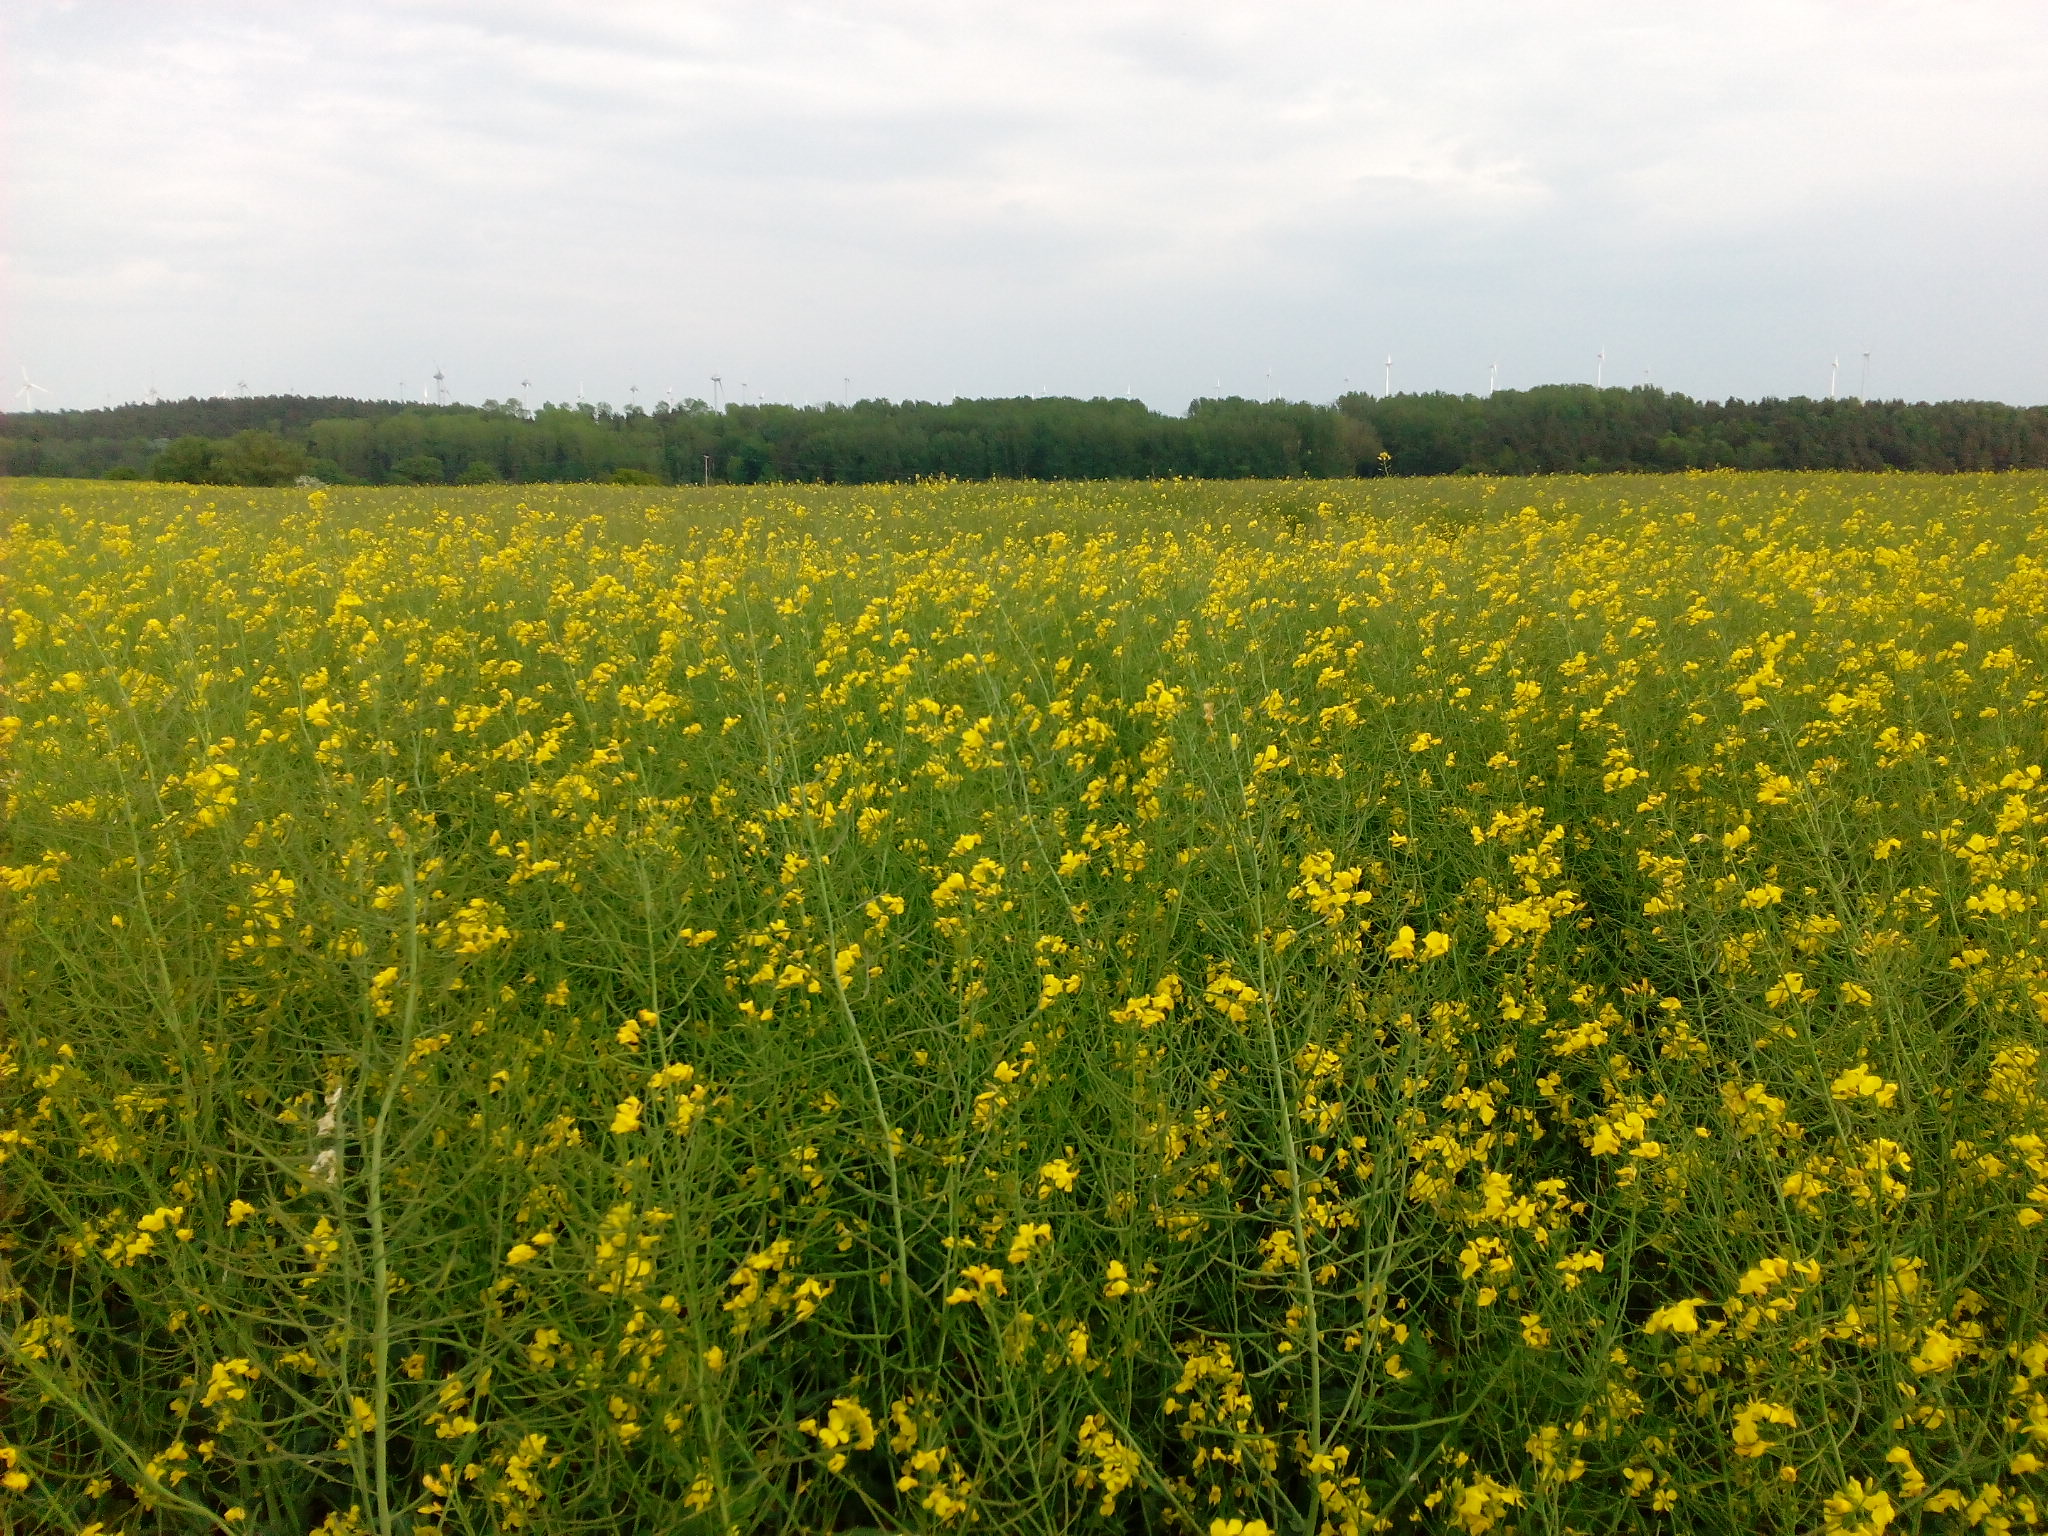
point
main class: Cropland
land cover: Rape and turnip rape
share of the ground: > 75 %
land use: Agriculture (excluding fallow land and kitchen gardens)
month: May
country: DE
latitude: 53.7179
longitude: 13.2575
